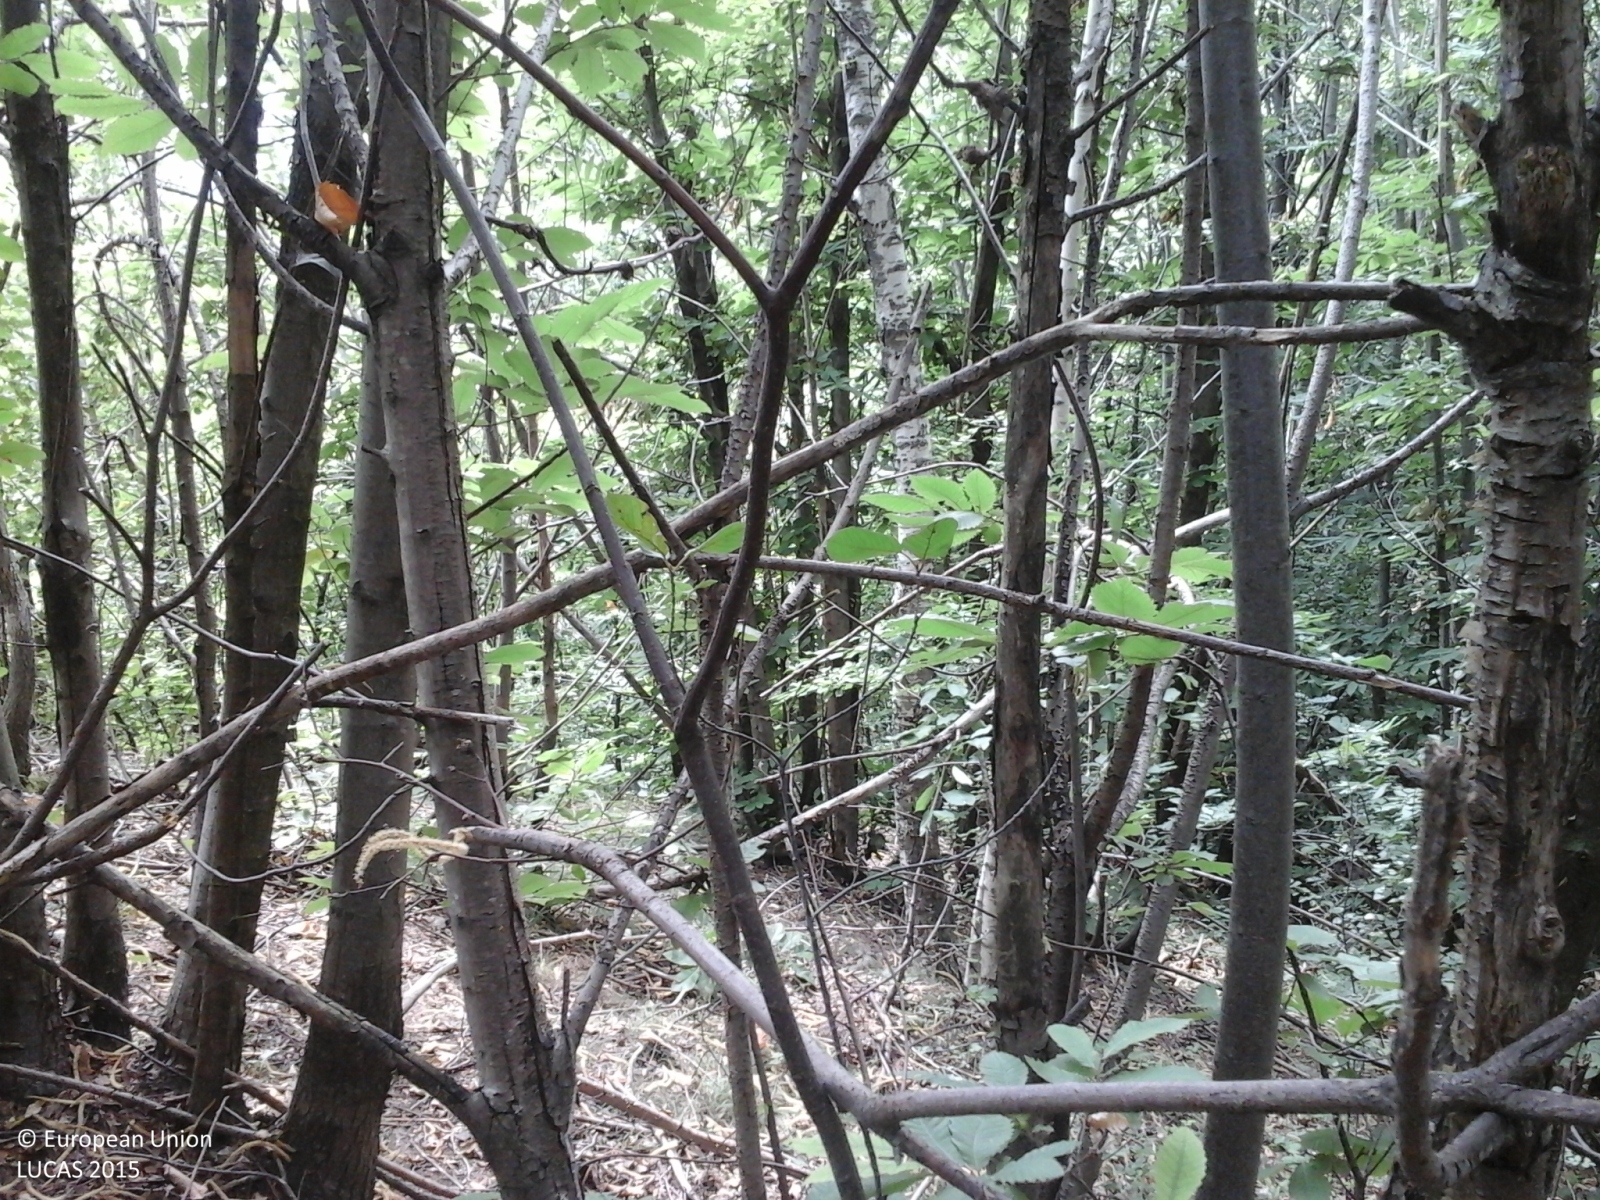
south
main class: Woodland
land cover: Broadleaved woodland
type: thermophilous deciduous forest
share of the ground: > 75 %
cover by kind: broadleaved forest trees 100 %
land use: Semi-natural and natural areas not in use
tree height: > 5 m
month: July
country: IT
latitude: 44.8923
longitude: 7.2825
